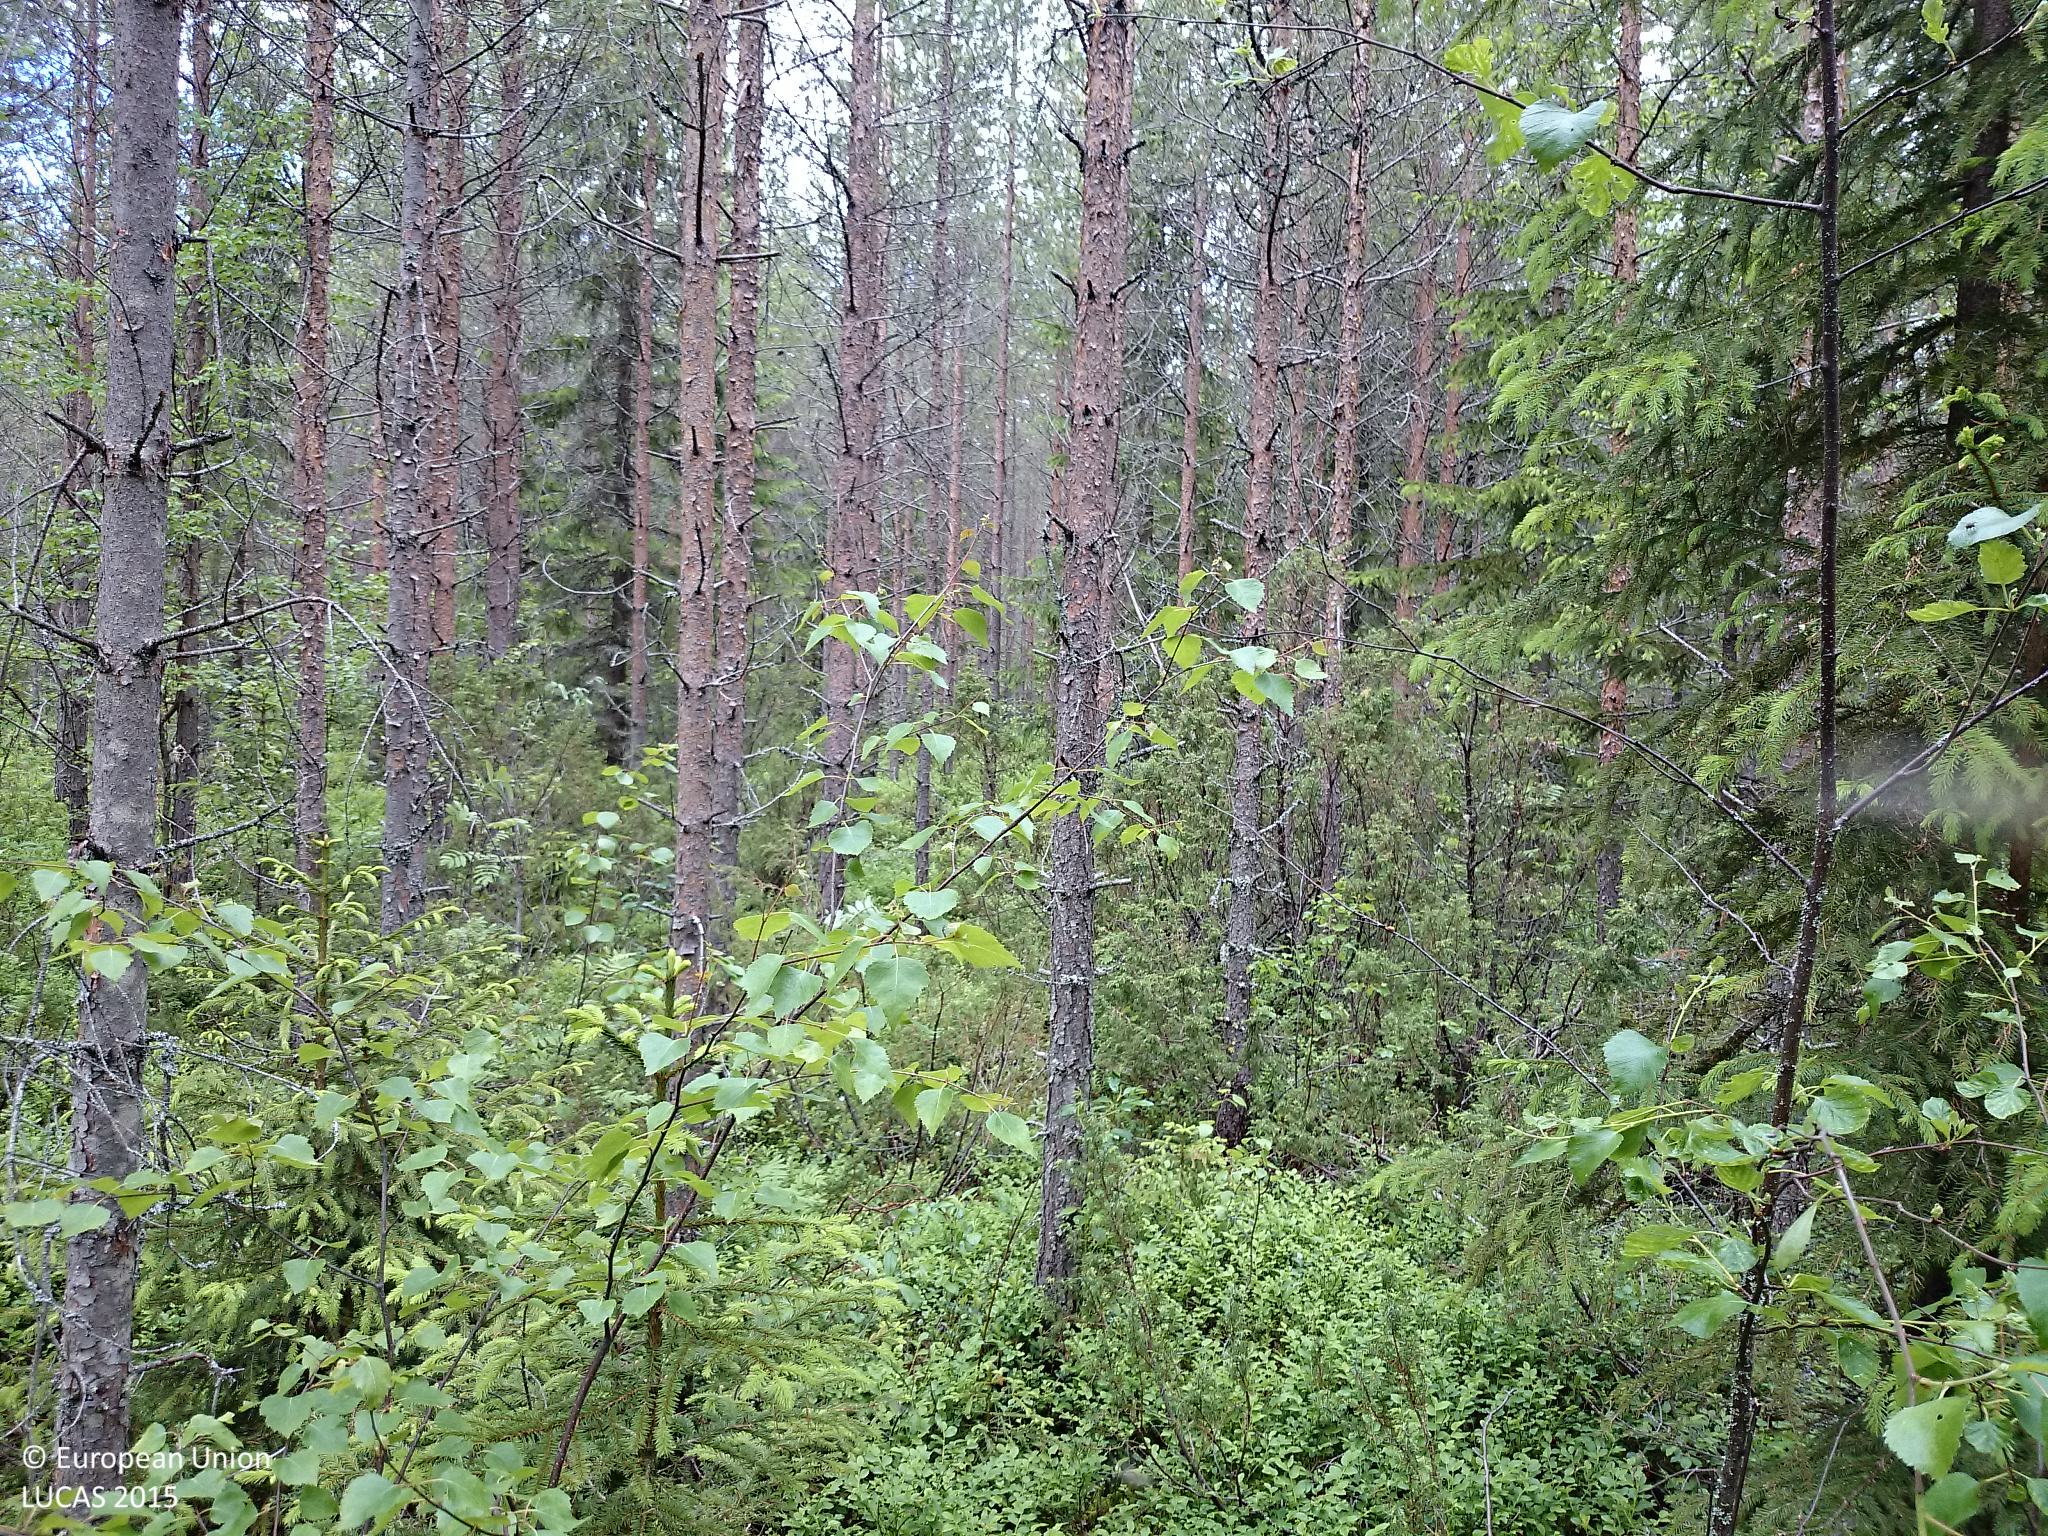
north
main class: Woodland
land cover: Pine dominated mixed woodland
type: boreal forest
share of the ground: > 75 %
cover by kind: coniferous forest trees 60 %, broadleaved forest trees 20 %, shrubs 20 %
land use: Forestry
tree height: > 5 m
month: June
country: SE
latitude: 64.1404
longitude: 20.7708
